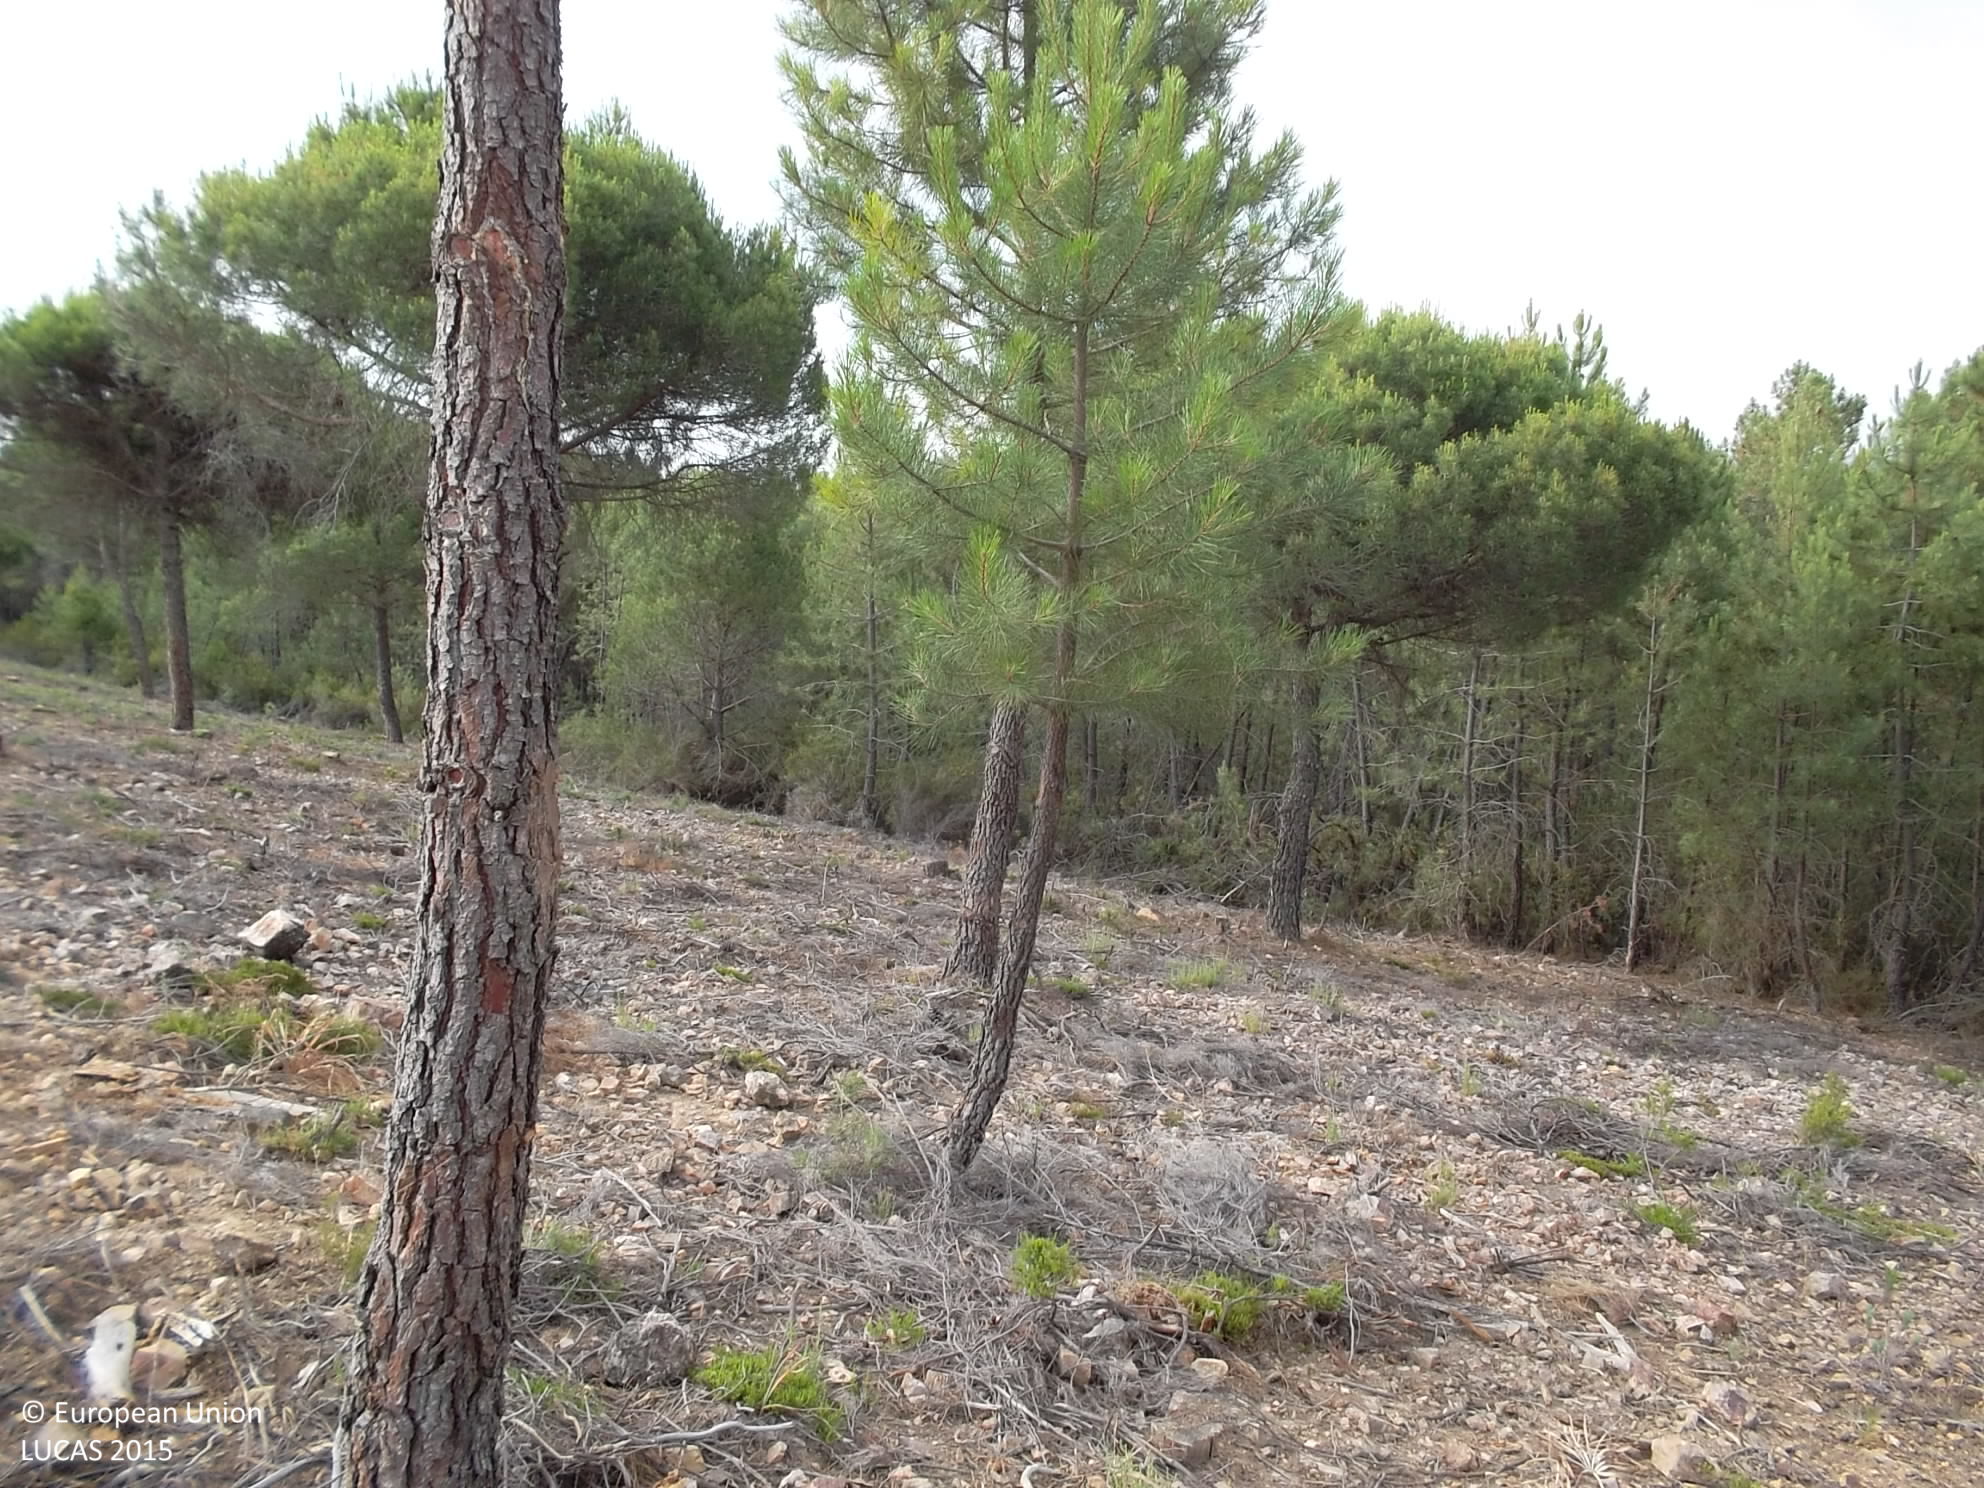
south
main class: Woodland
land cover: Pine dominated coniferous woodland
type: coniferous forest of the mediterranean region
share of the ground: 50 - 75 %
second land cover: Spontaneously vegetated surfaces
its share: > 75 %
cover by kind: coniferous forest trees 40 %, herbaceous plants 40 %, unconsolidated bare surface 20 %
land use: Forestry
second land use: Agriculture (excluding fallow land and kitchen gardens)
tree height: > 5 m
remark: Clear cut
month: June
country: ES
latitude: 39.1828
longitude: -4.8660
